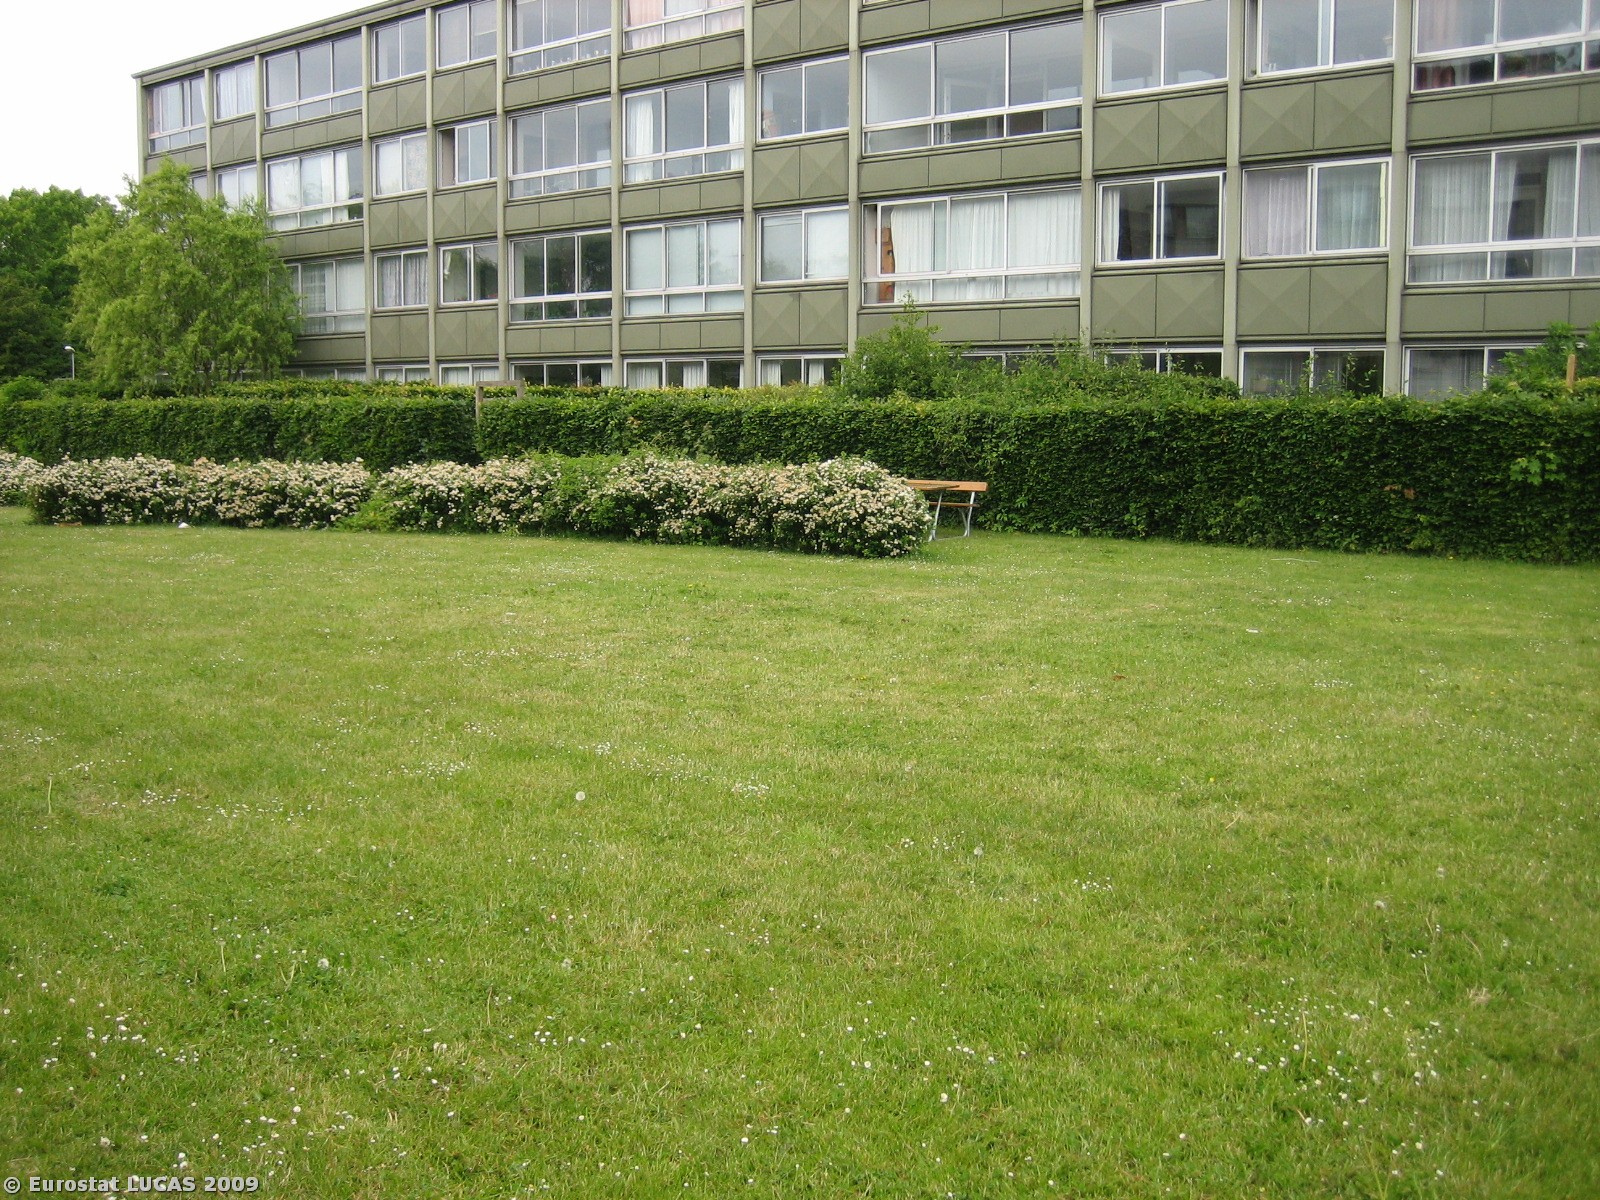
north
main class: Grassland
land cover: Grassland without tree/shrub cover
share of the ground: > 75 %
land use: Residential
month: June
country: DK
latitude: 56.1157
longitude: 10.1446
